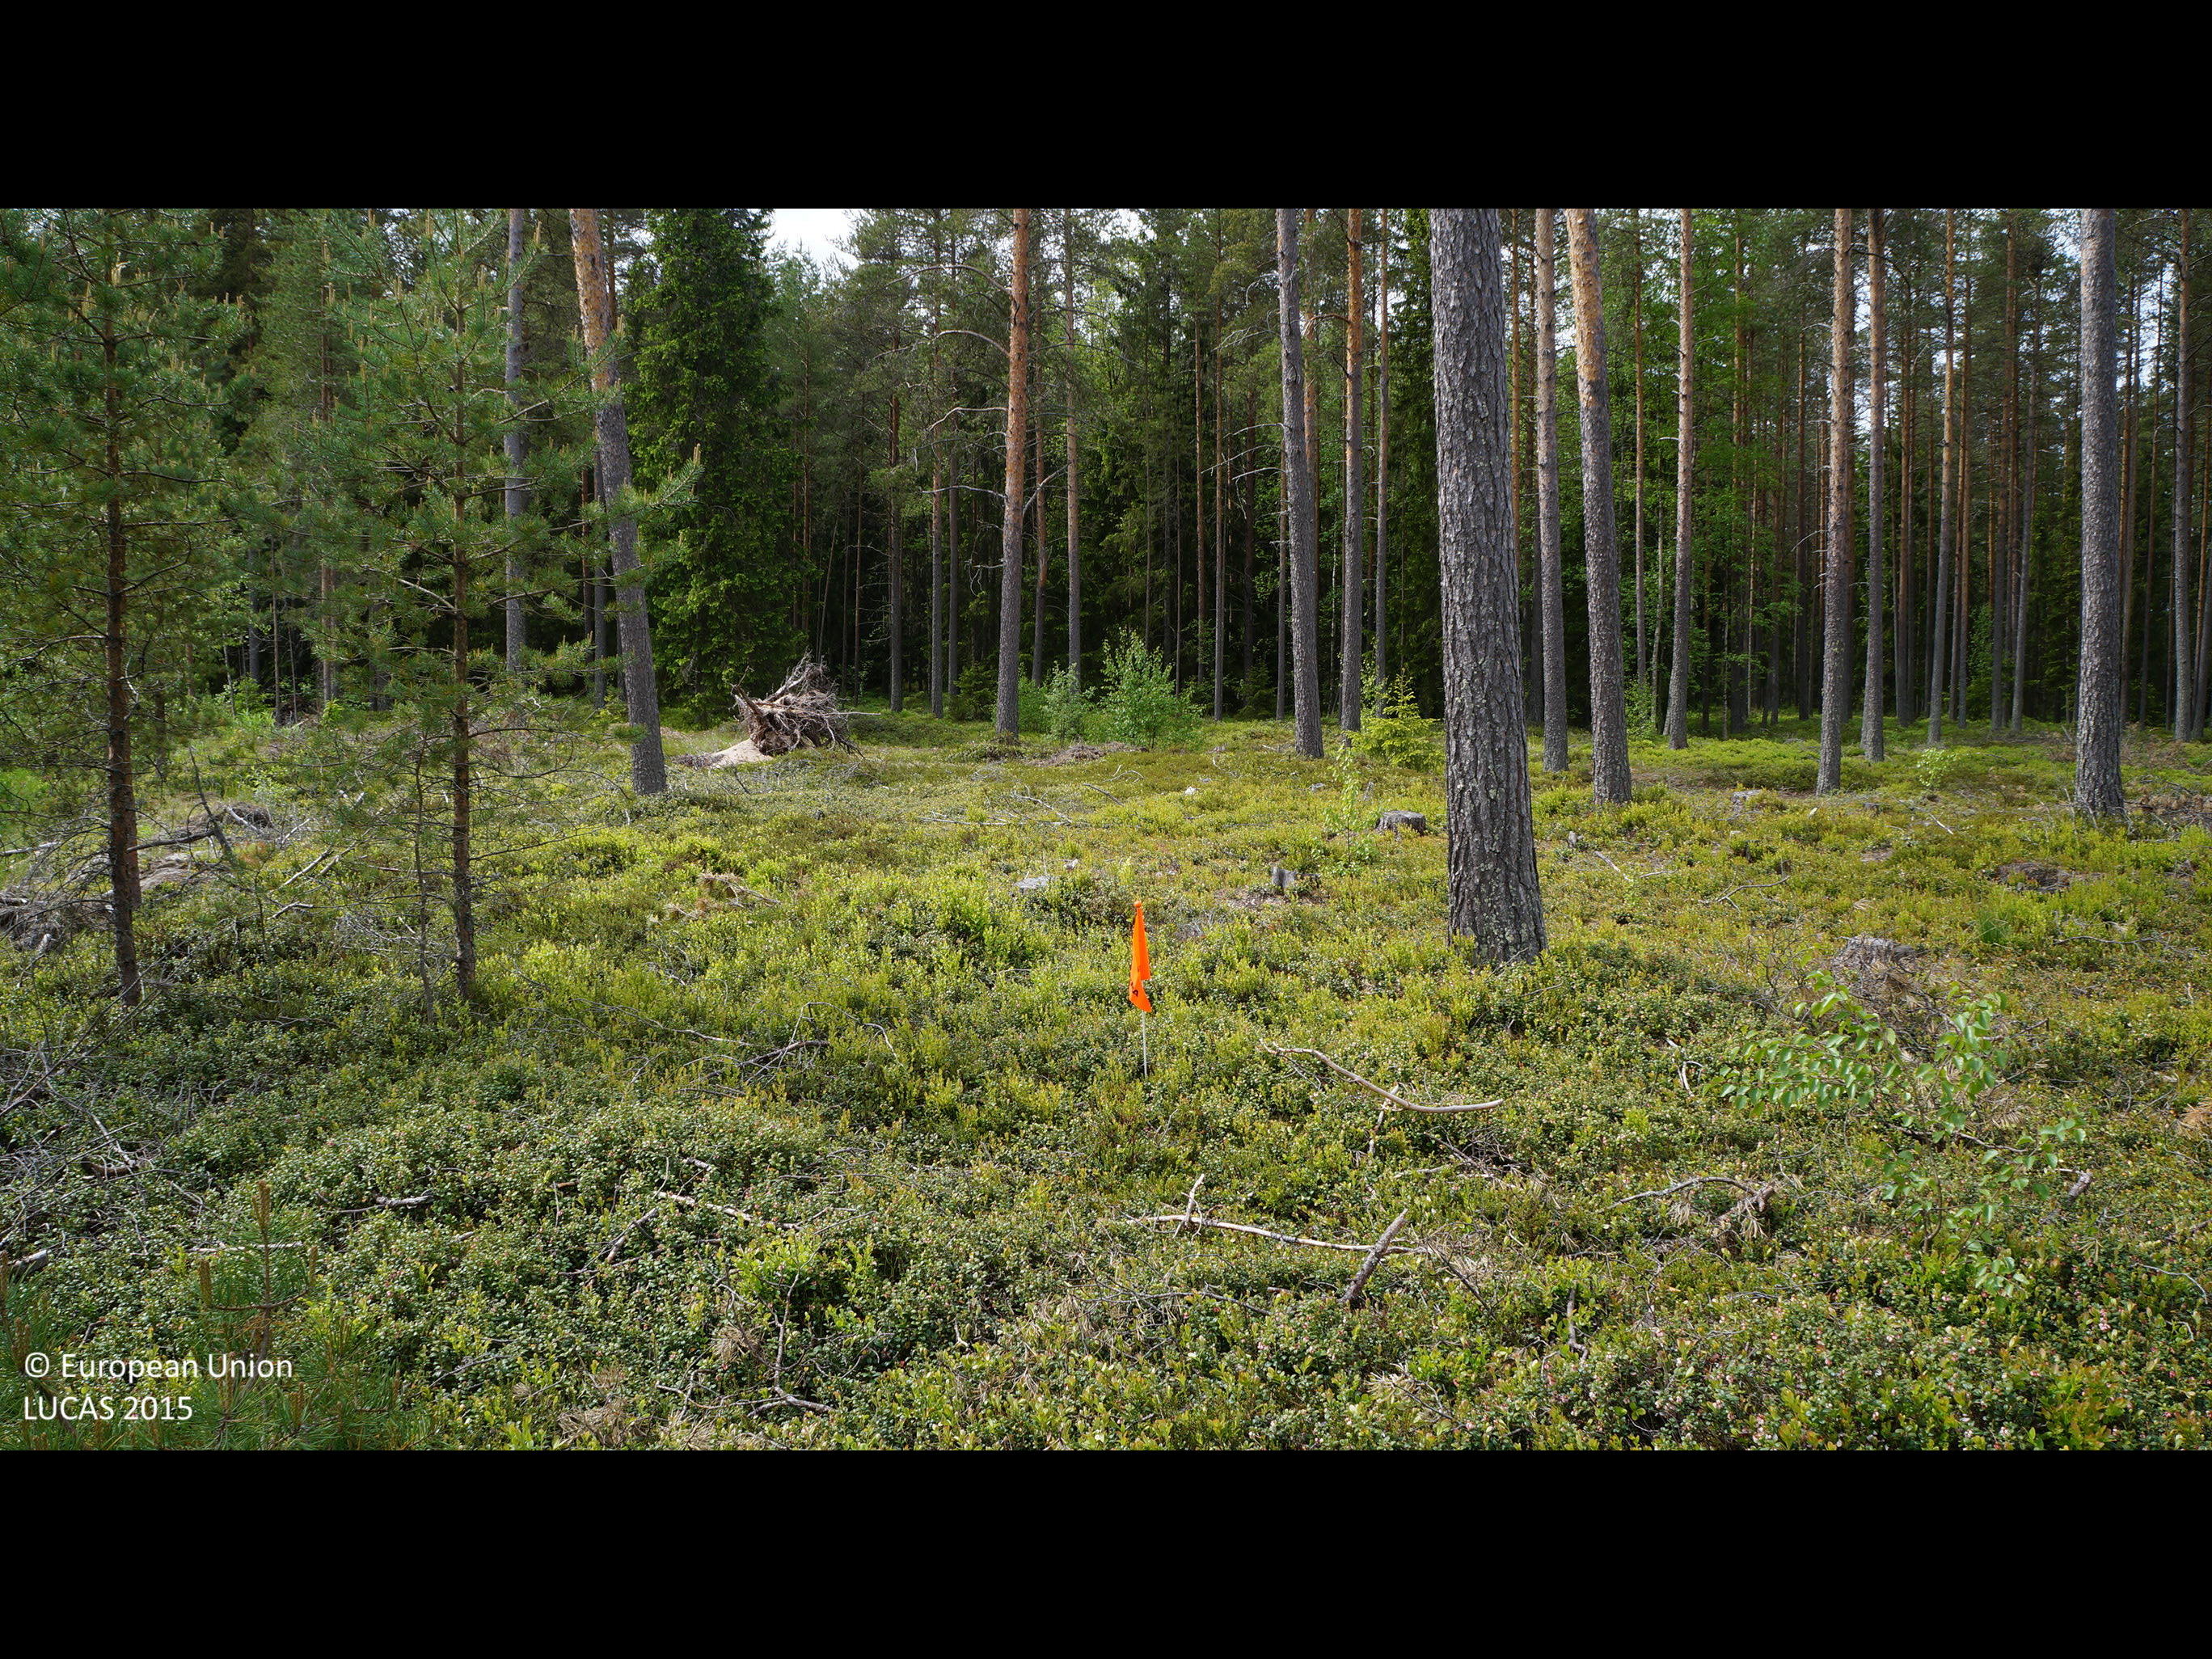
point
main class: Woodland
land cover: Pine dominated coniferous woodland
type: boreal forest
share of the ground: 50 - 75 %
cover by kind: coniferous forest trees 70 %, herbaceous plants 15 %, shrubs 10 %, lichens and mosses 5 %
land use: Forestry
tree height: > 5 m
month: June
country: FI
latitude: 63.9707
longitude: 23.4343
